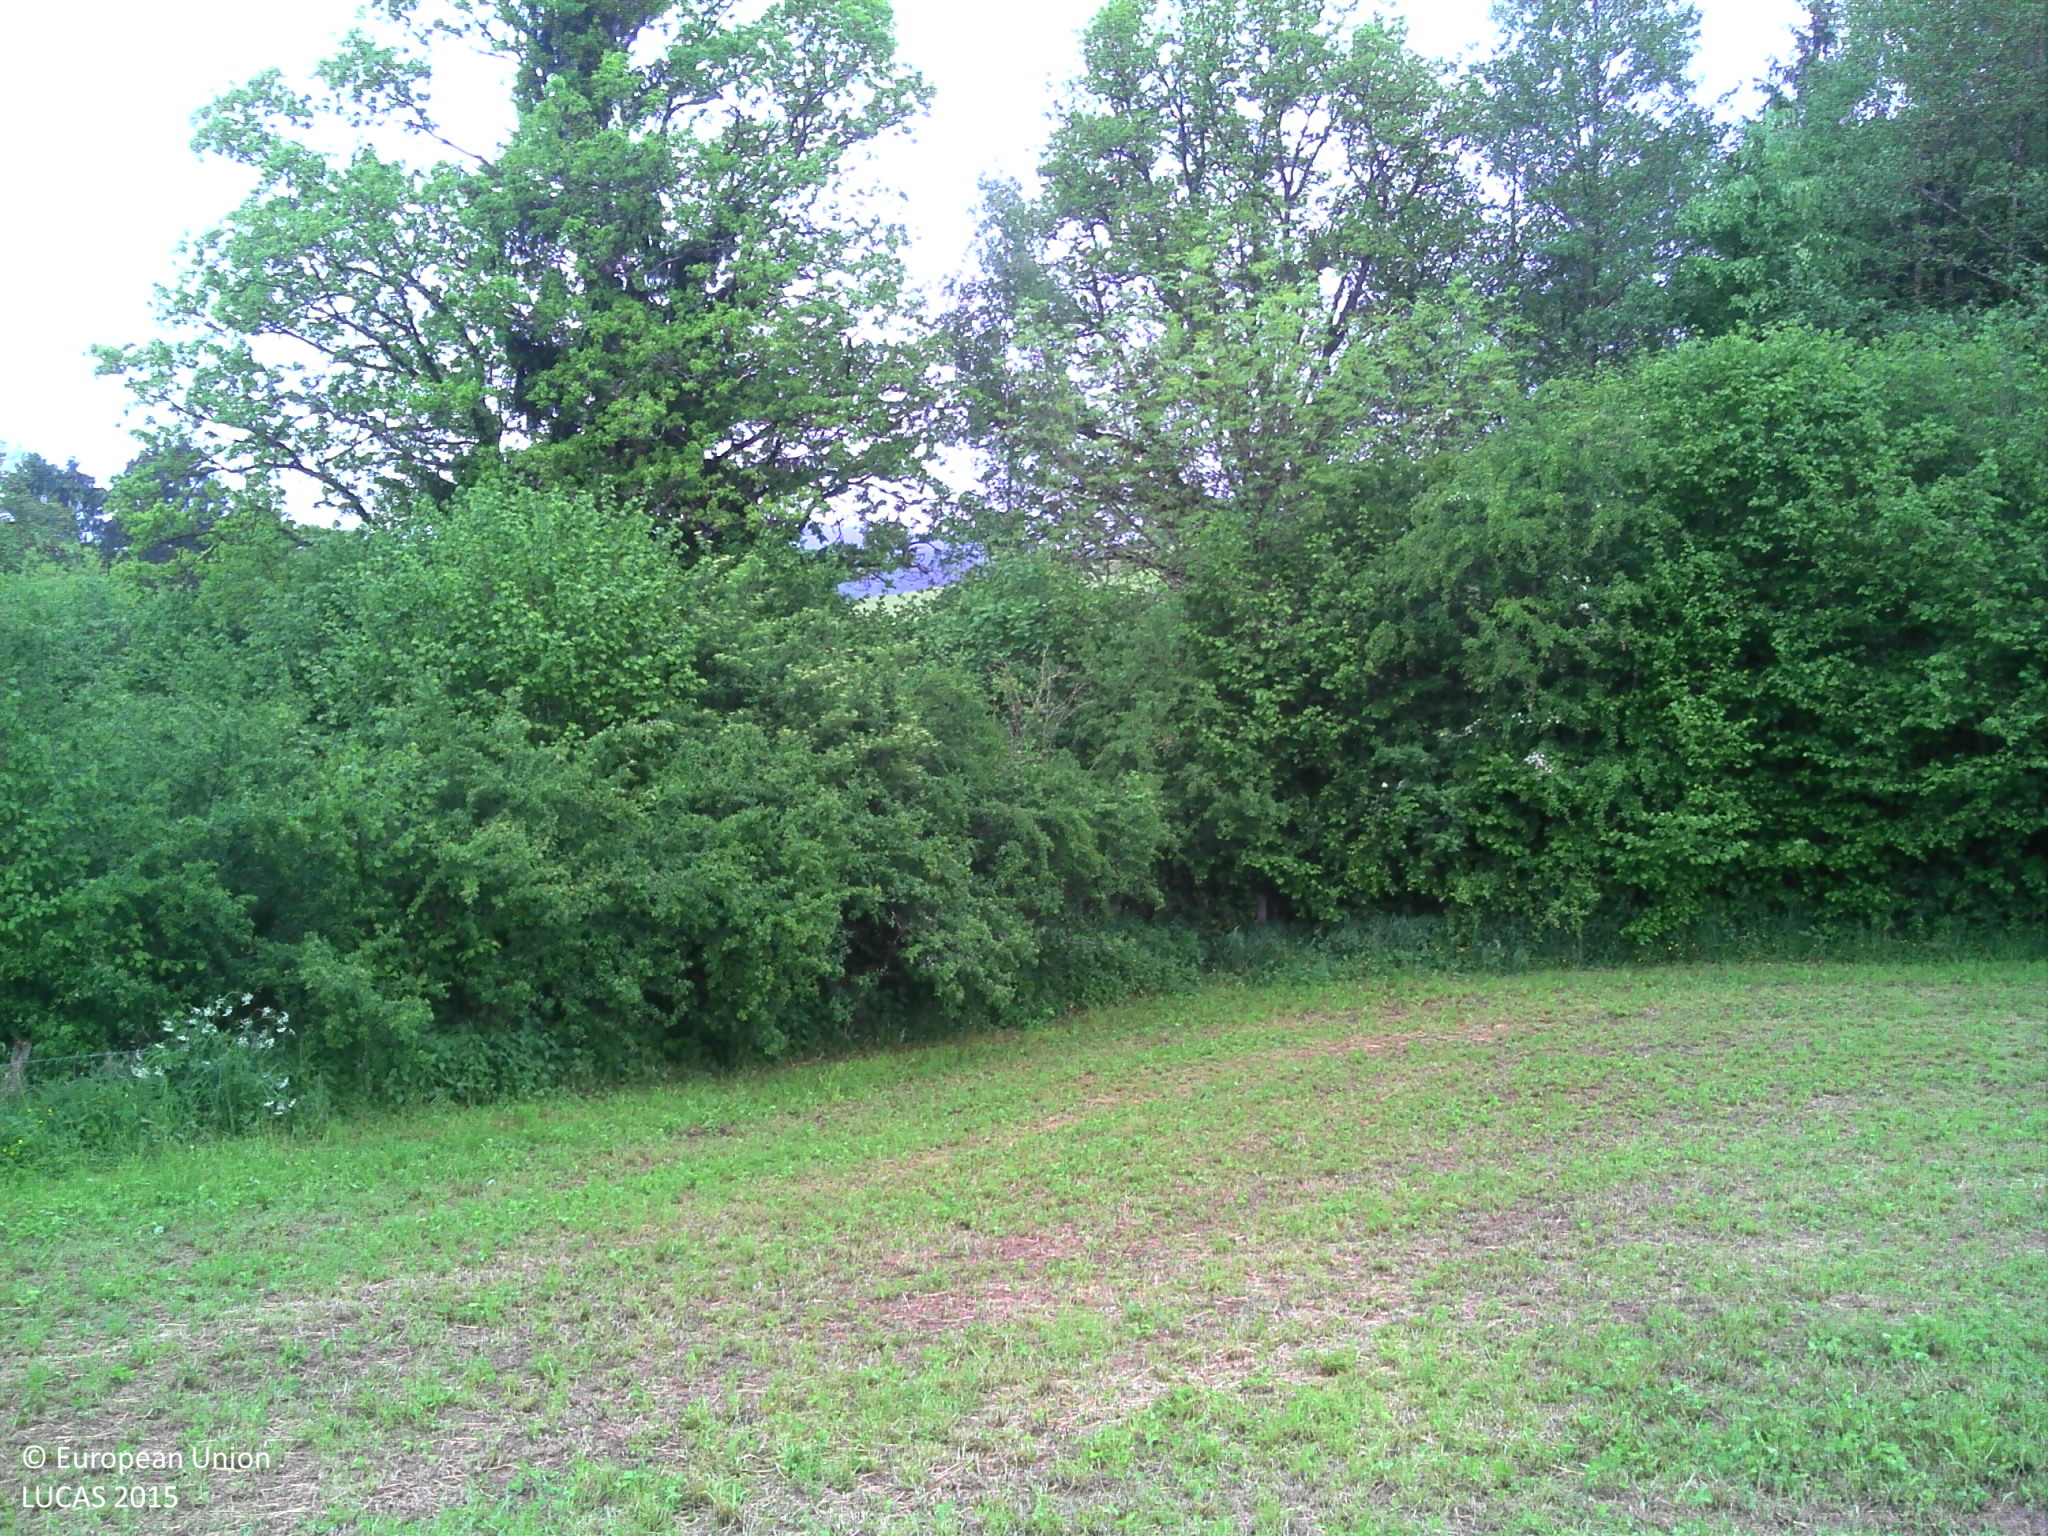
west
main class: Grassland
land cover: Grassland without tree/shrub cover
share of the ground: > 75 %
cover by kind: herbaceous plants 100 %
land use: Agriculture (excluding fallow land and kitchen gardens)
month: June
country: BE
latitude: 50.3219
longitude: 5.7710
